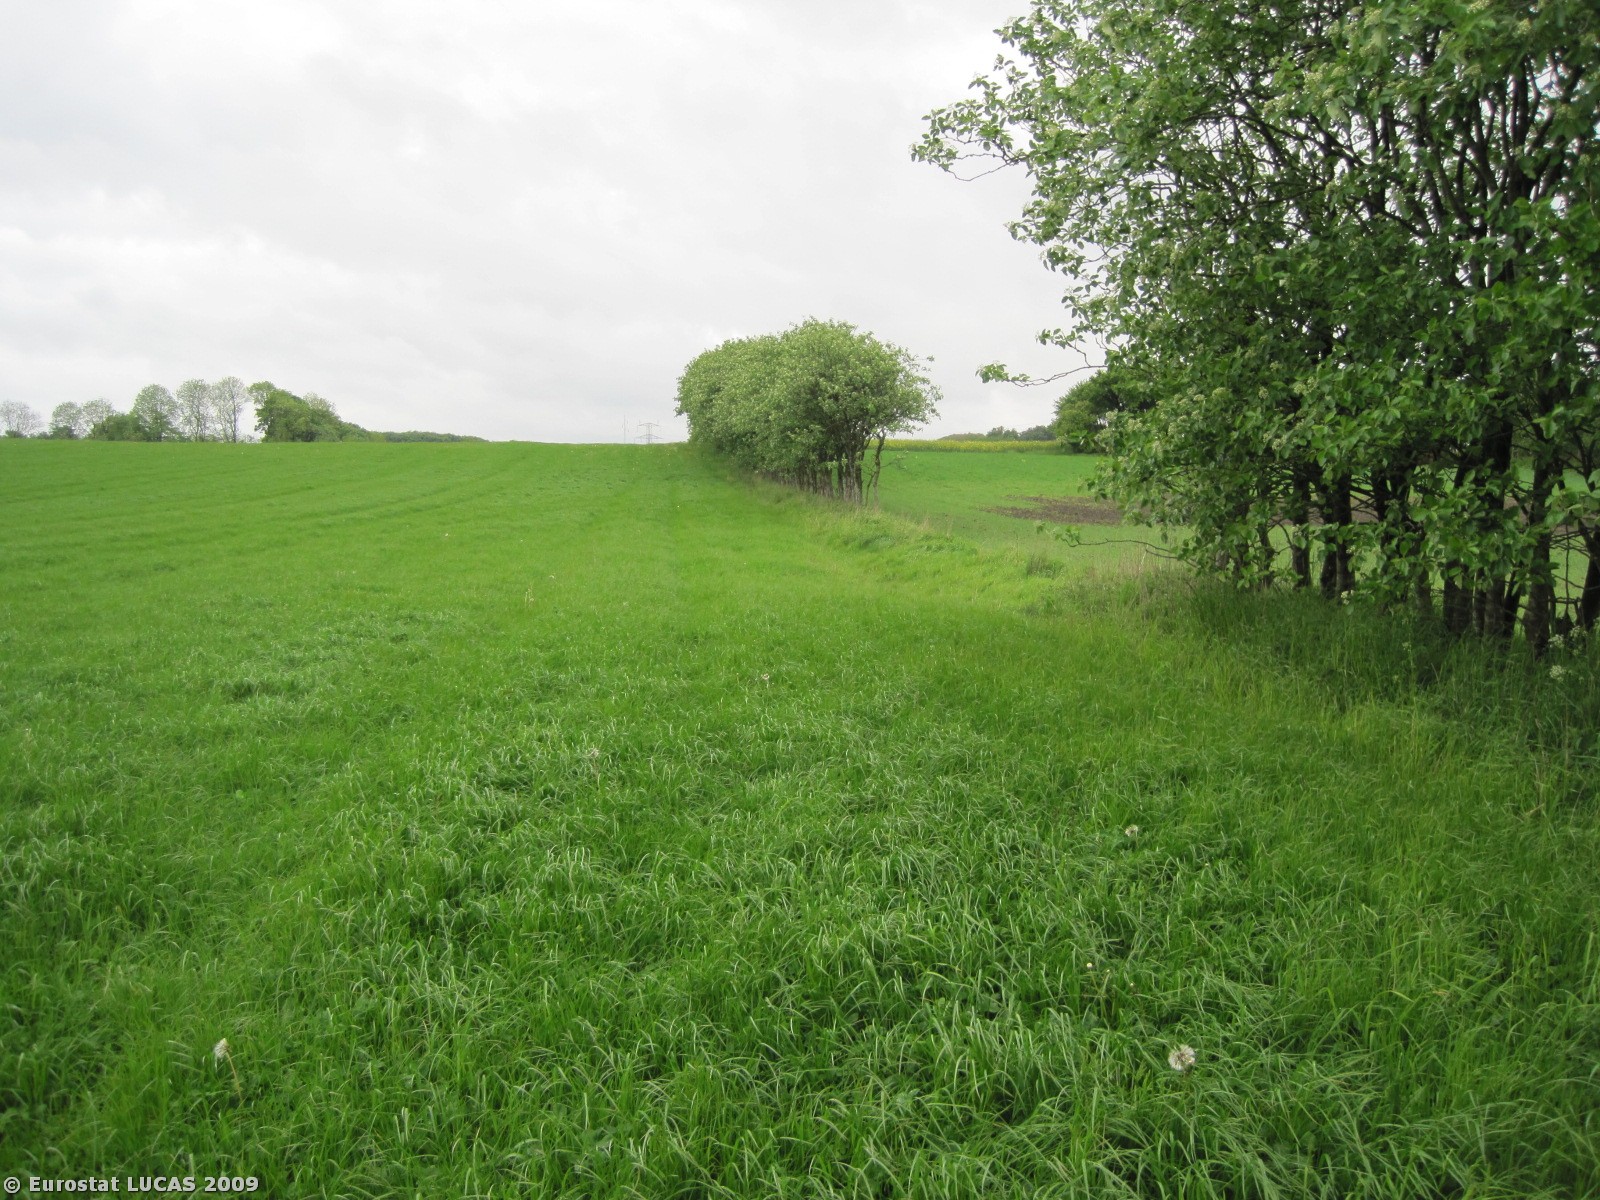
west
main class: Grassland
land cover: Grassland without tree/shrub cover
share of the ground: > 75 %
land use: Agriculture (excluding fallow land and kitchen gardens)
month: May
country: DK
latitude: 56.8347
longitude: 9.7545
